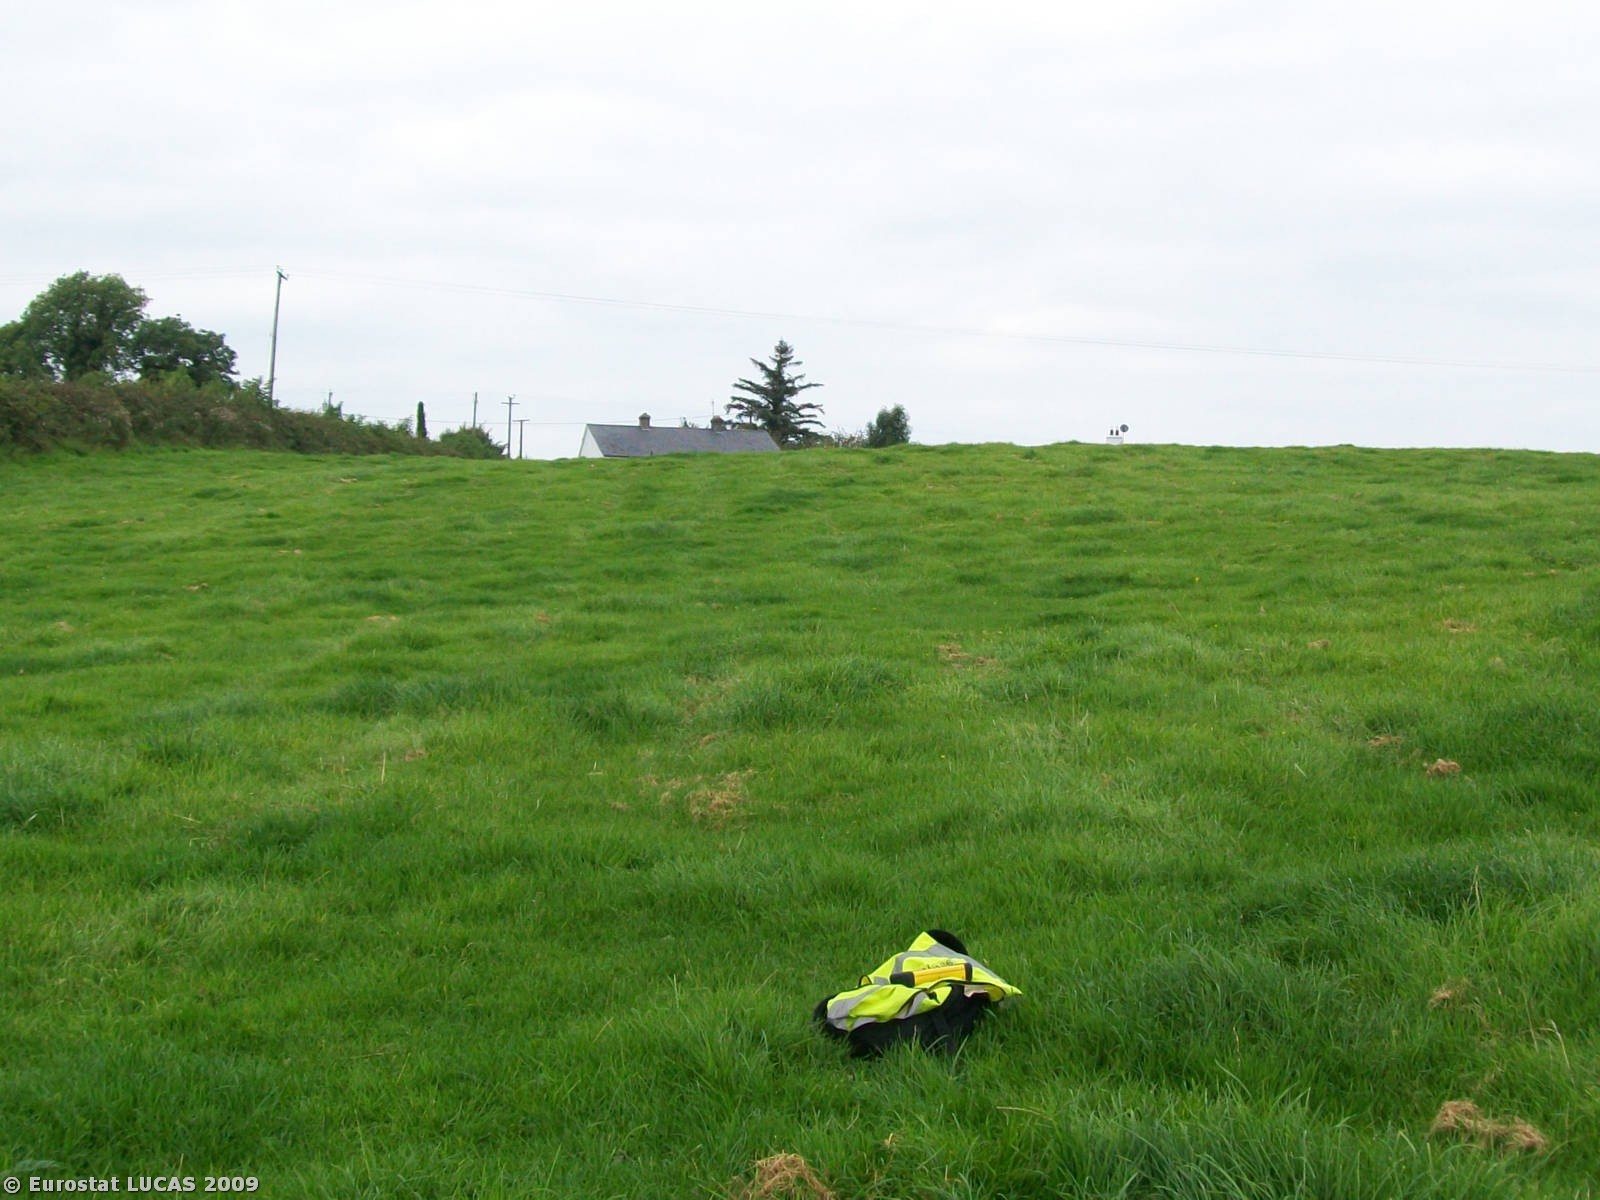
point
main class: Grassland
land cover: Grassland without tree/shrub cover
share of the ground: > 75 %
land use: Agriculture (excluding fallow land and kitchen gardens)
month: September
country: IE
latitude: 52.9687
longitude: -7.8137
